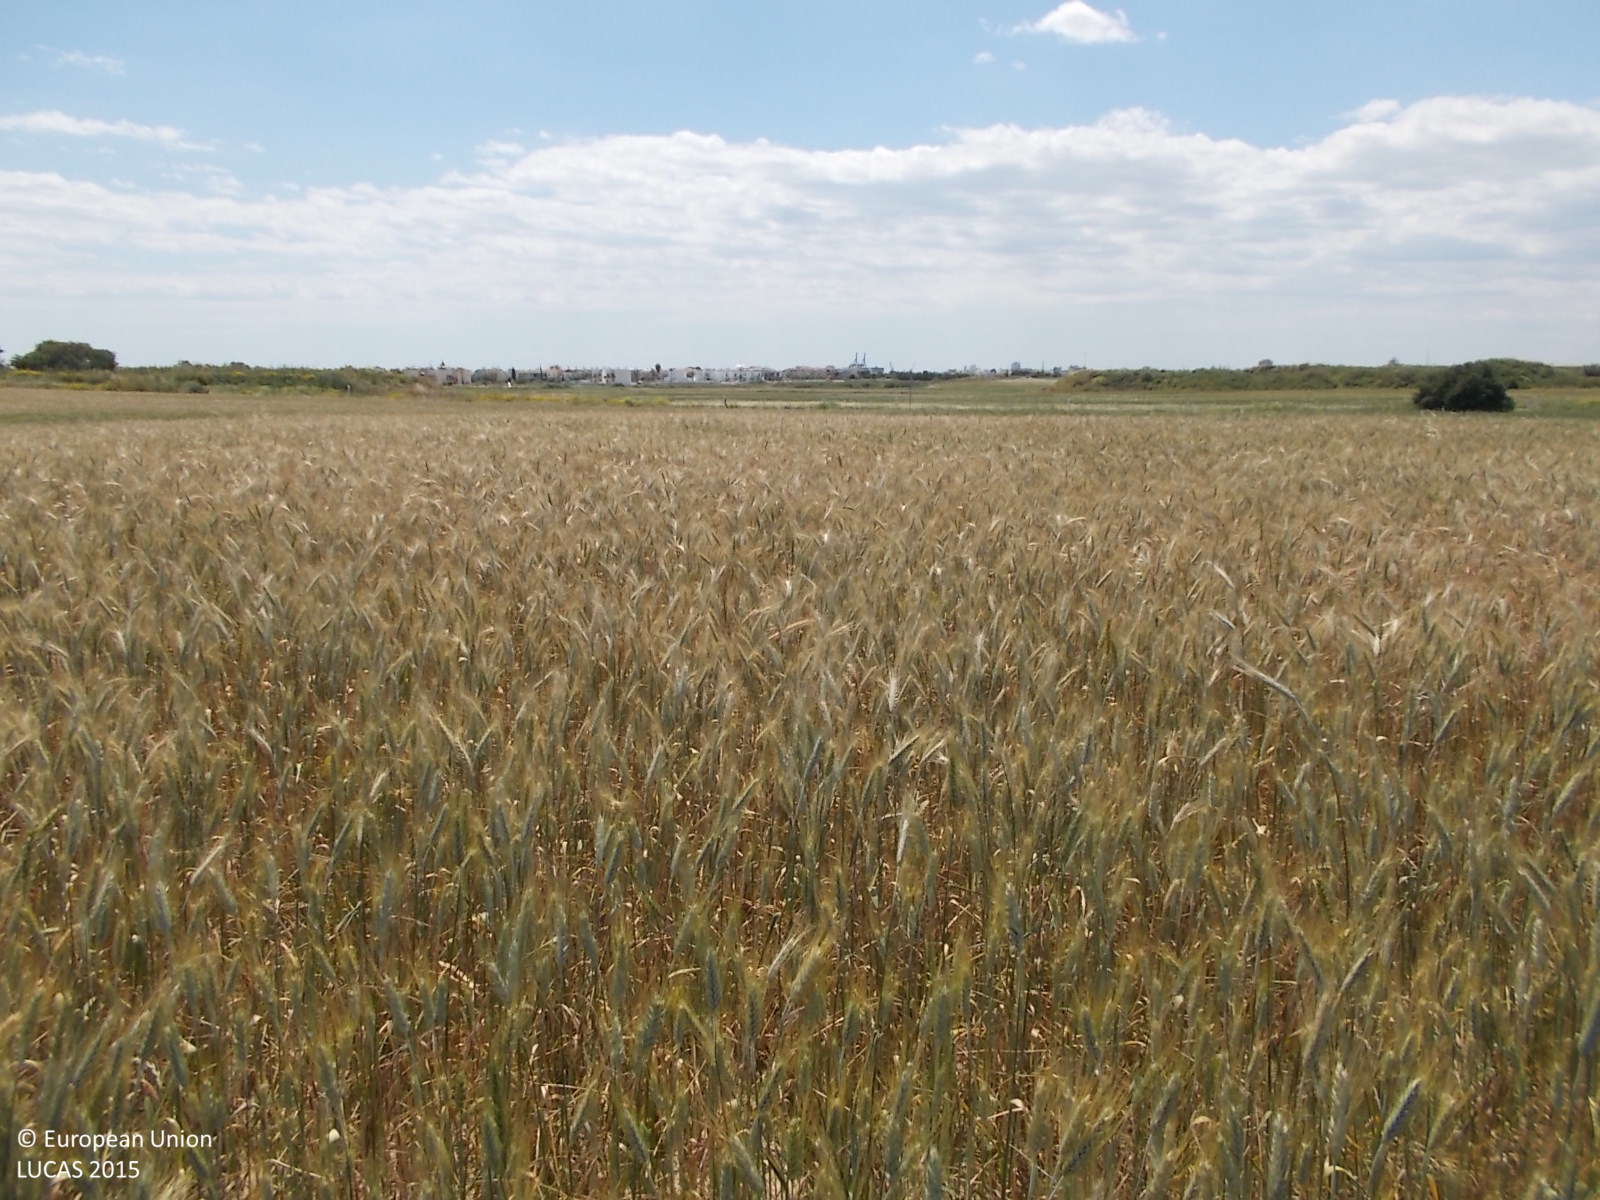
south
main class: Cropland
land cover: Common wheat
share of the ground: > 75 %
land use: Agriculture (excluding fallow land and kitchen gardens)
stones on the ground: < 10 %
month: April
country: CY
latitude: 34.9641
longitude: 33.6470
